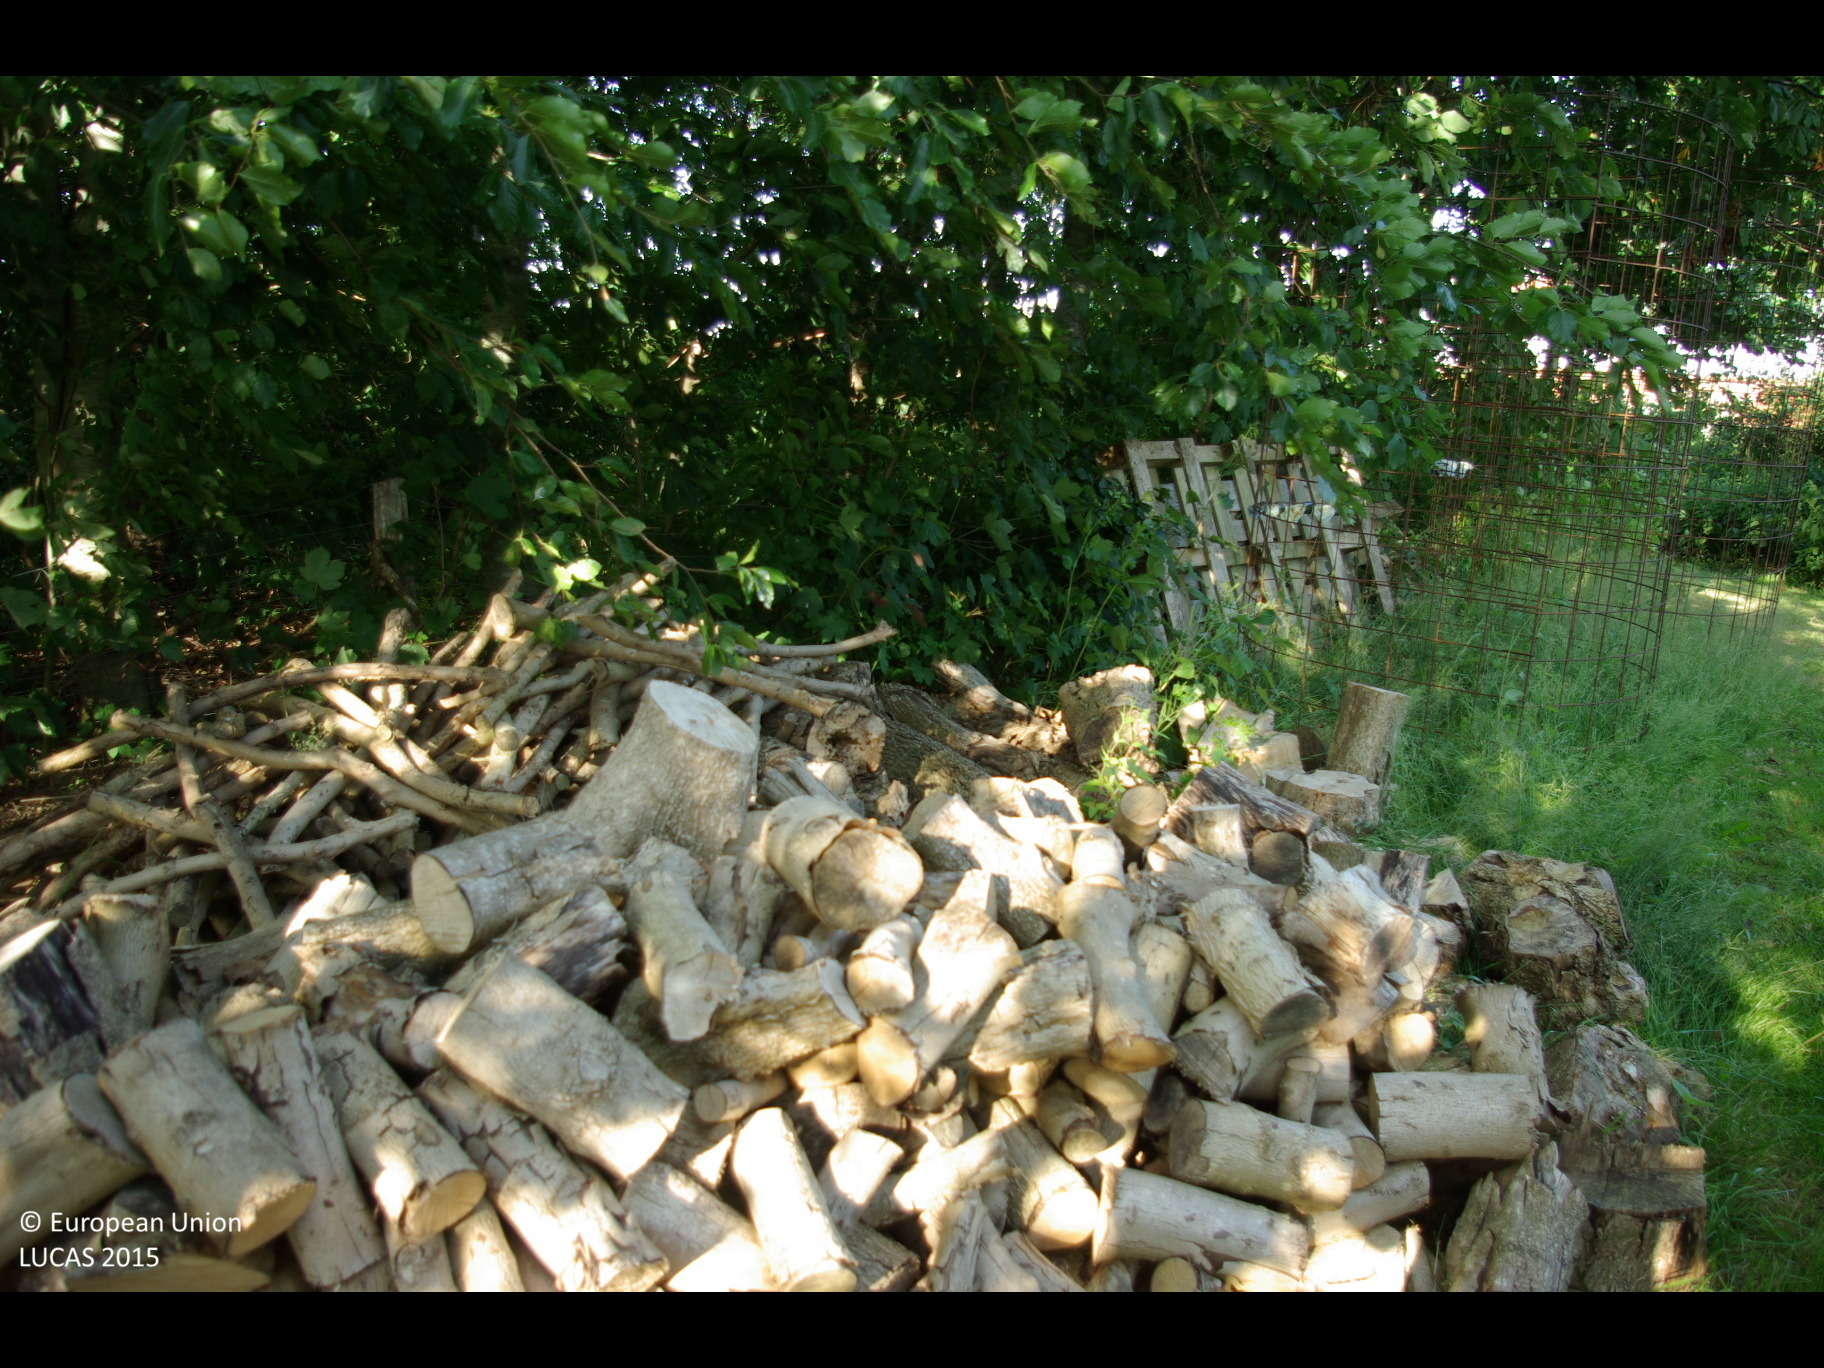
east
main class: Grassland
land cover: Grassland without tree/shrub cover
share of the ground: > 75 %
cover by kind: herbaceous plants 100 %
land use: Residential
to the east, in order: Grassland without tree/shrub cover; Fences; Broadleaved woodland; Grass margins; Broadleaved woodland; Common wheat
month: July
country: DE
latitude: 54.7138
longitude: 9.8604
